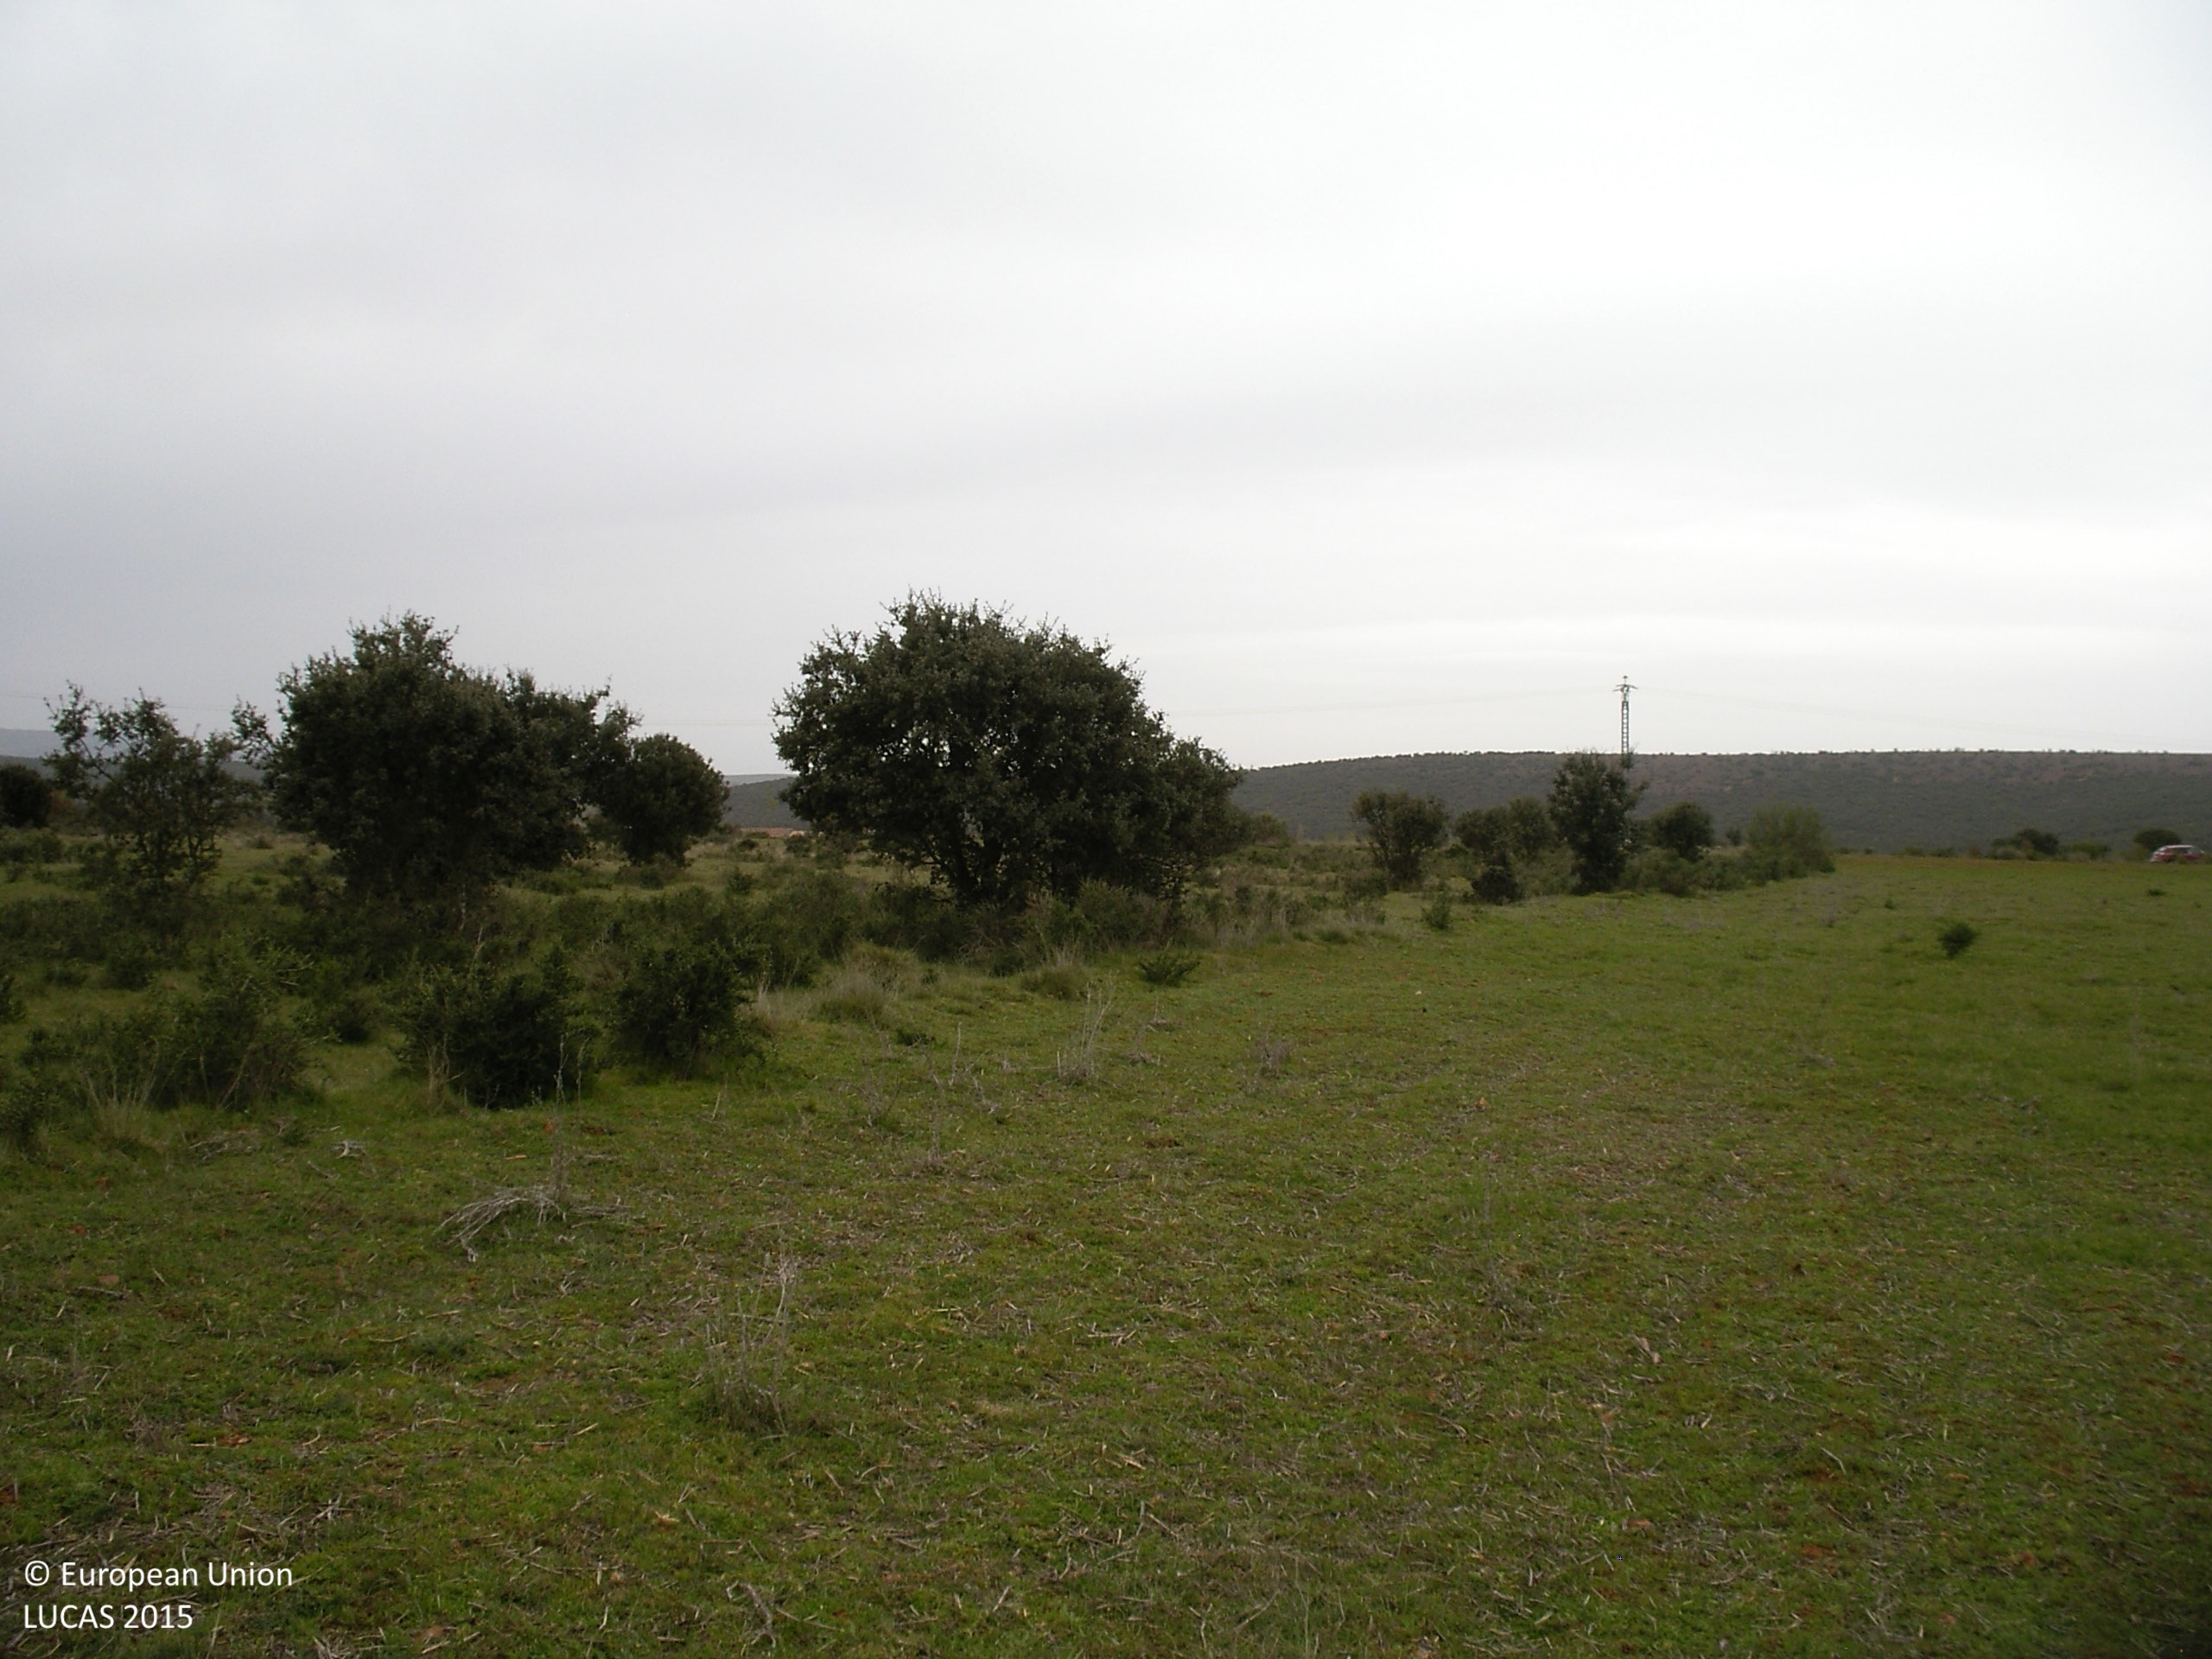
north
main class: Grassland
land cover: Spontaneously vegetated surfaces
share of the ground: > 75 %
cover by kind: herbaceous plants 95 %, shrubs 5 %
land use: Agriculture (excluding fallow land and kitchen gardens)
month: April
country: ES
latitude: 42.4553
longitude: -6.1218
